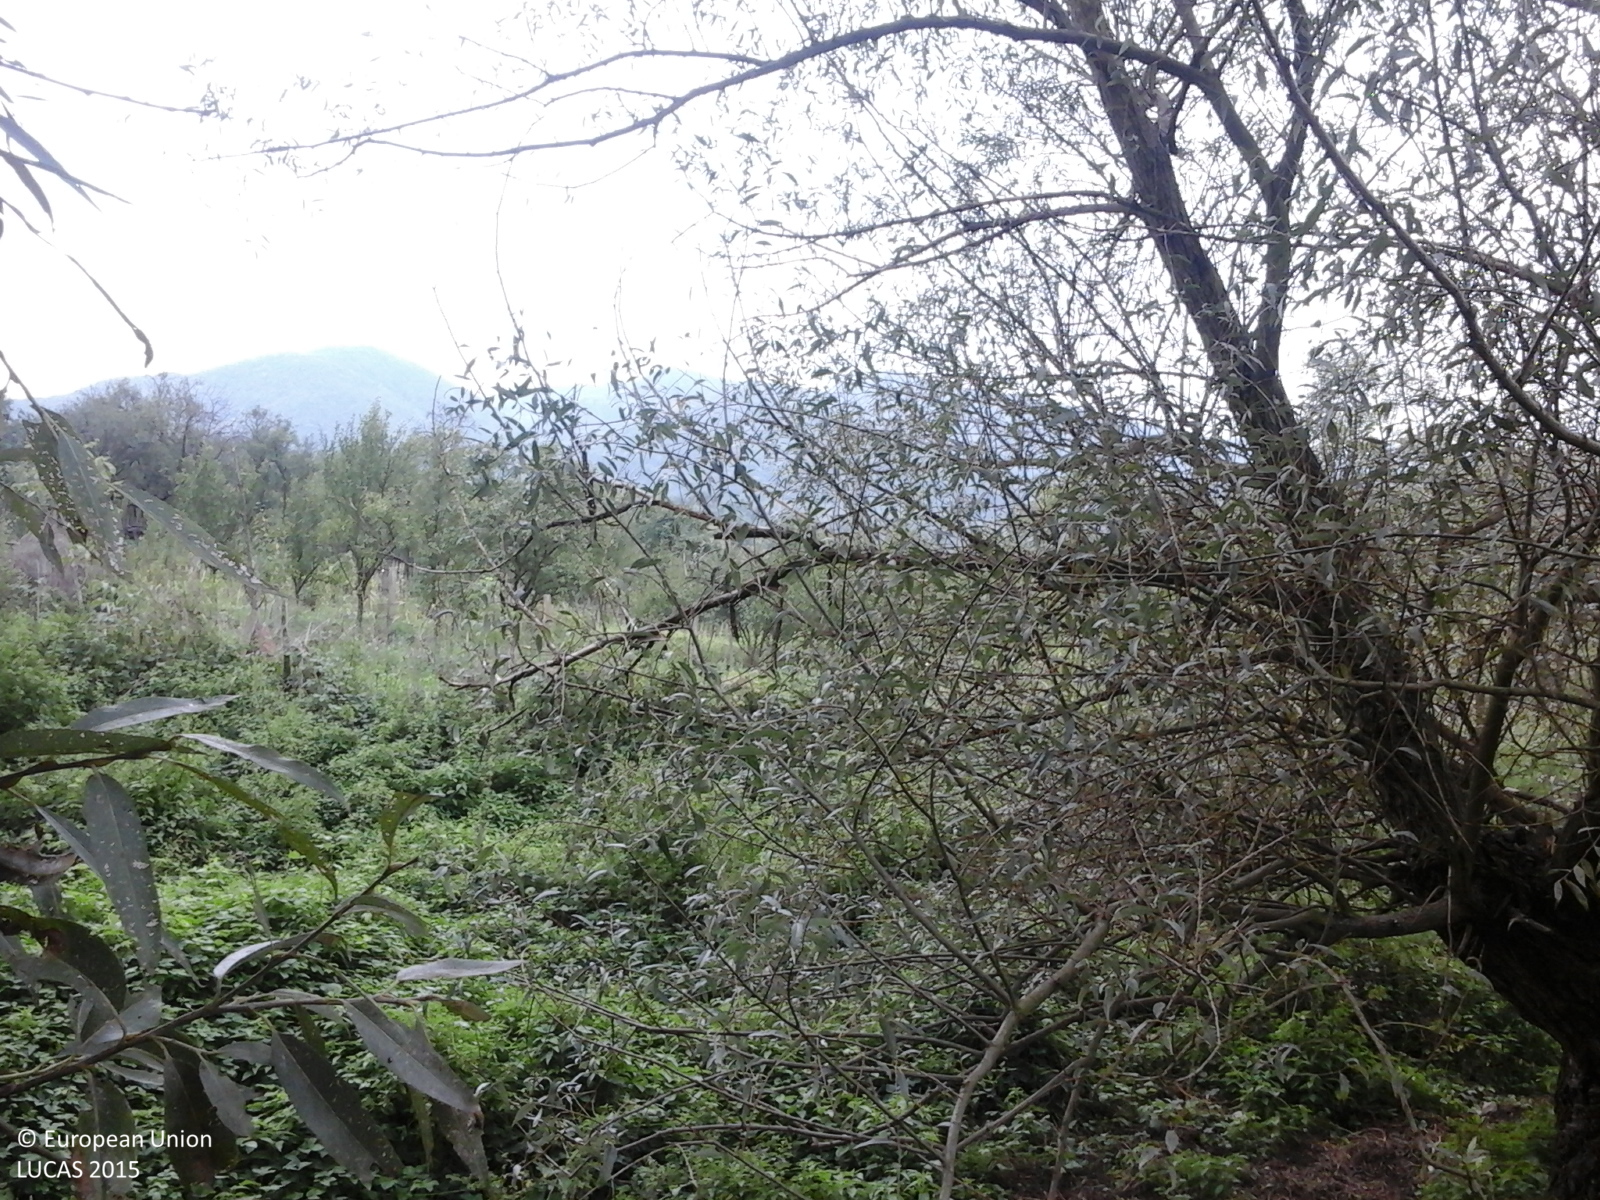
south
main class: Grassland
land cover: Grassland with sparse tree/shrub cover
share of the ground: > 75 %
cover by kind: herbaceous plants 90 %, broadleaved forest trees 5 %, shrubs 5 %
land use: Agriculture (excluding fallow land and kitchen gardens)
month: September
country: RO
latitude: 45.8081
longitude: 23.3010
